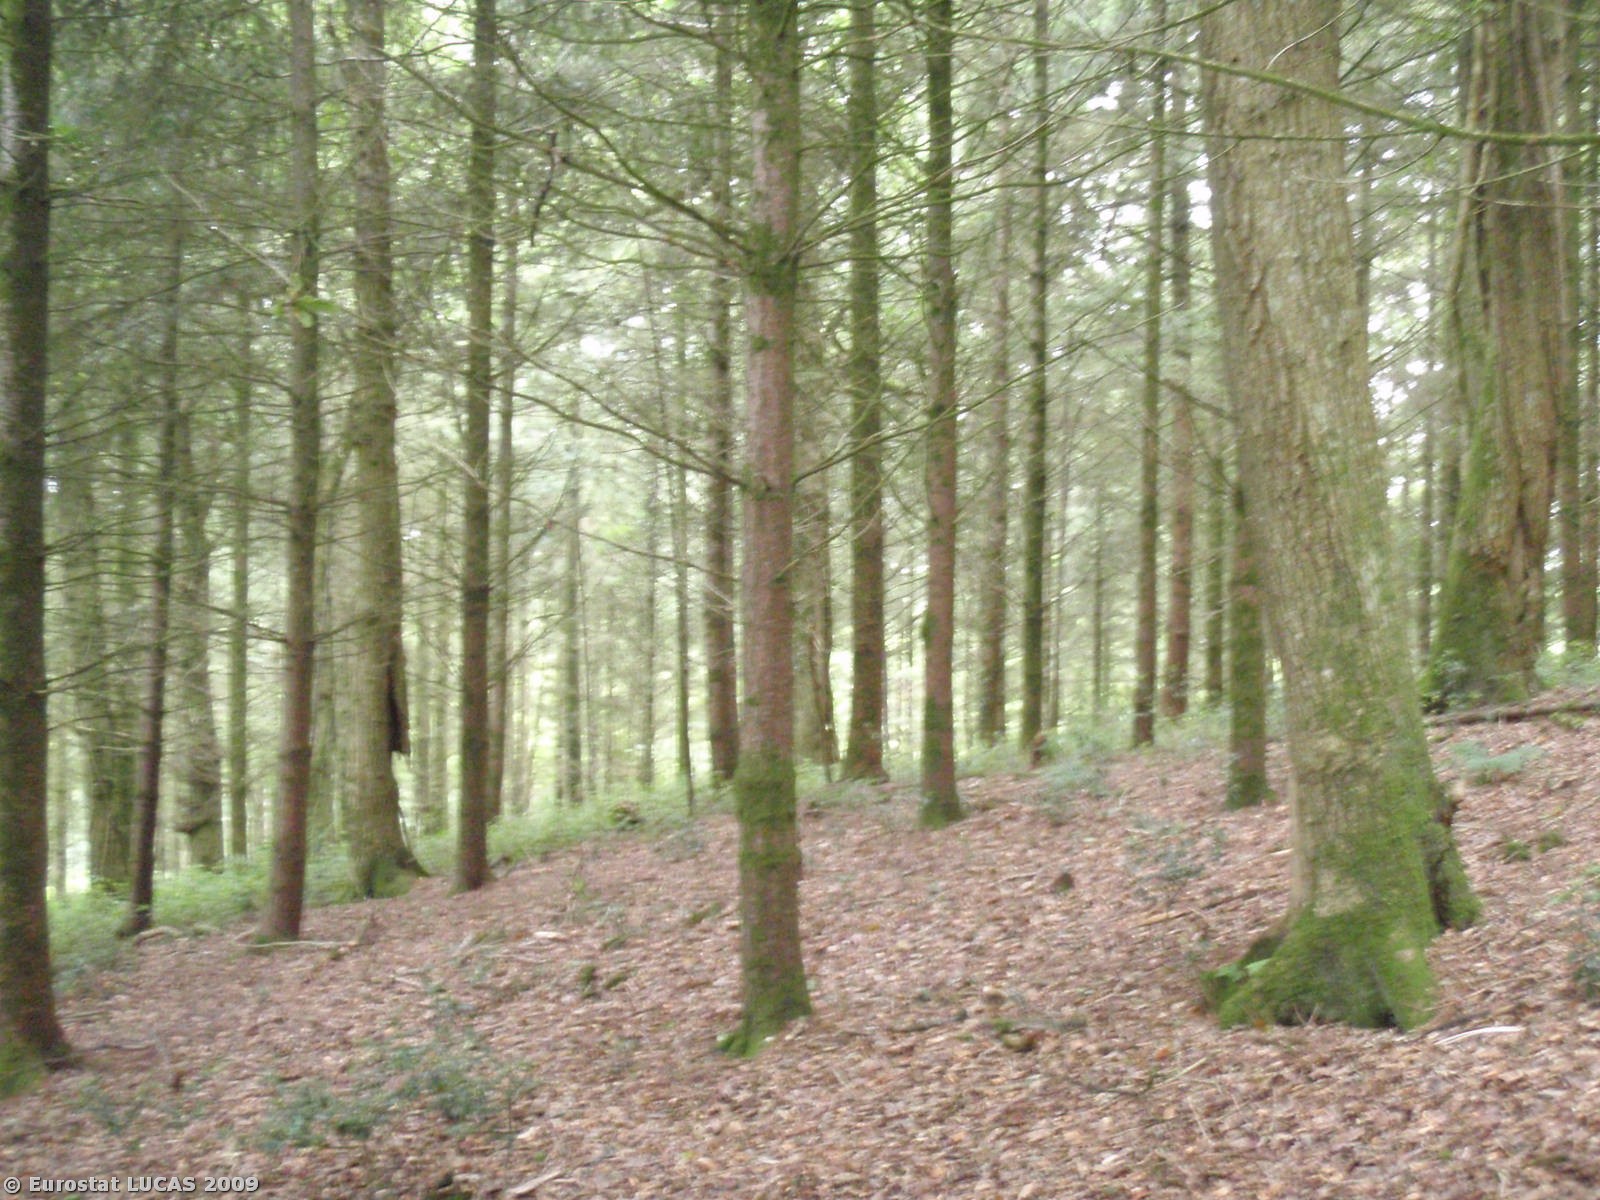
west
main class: Woodland
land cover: Coniferous woodland
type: plantations and self-sown exotic forest
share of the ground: > 75 %
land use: Forestry
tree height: > 5 m
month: August
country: GB
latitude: 50.7296
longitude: -4.3683
